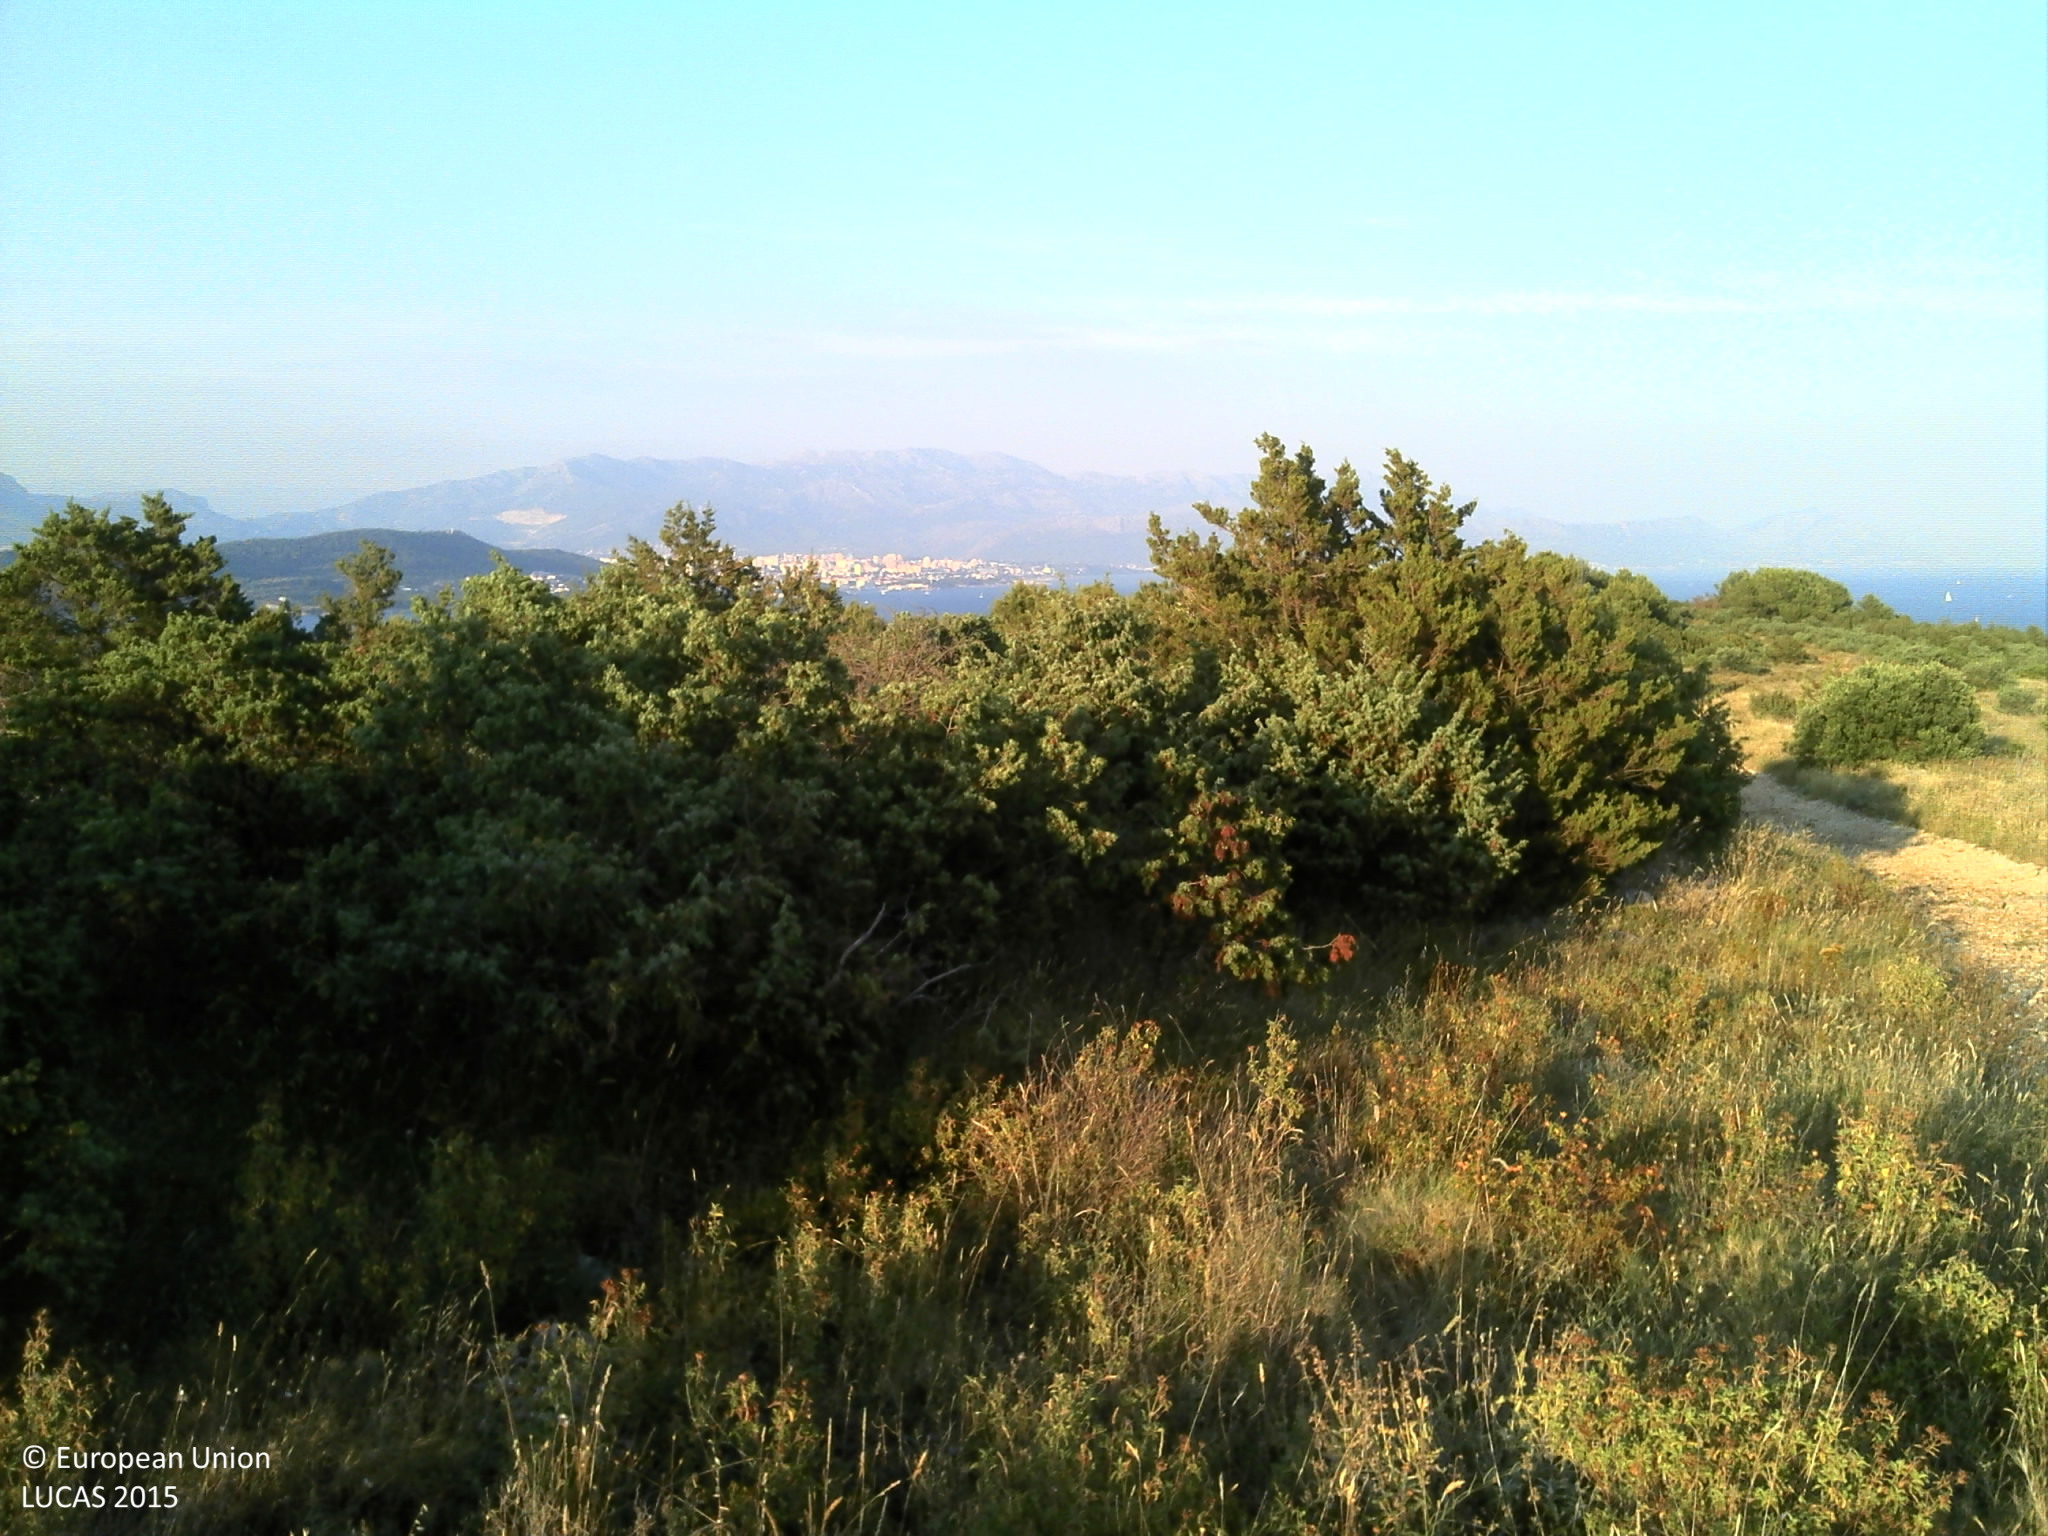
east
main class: Shrubland
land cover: Shrubland without tree cover
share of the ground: 50 - 75 %
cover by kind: shrubs 70 %, herbaceous plants 20 %, consolidated bare surface 5 %, unconsolidated bare surface 5 %
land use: Semi-natural and natural areas not in use
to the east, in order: Tracks; Shrubland without tree cover; Dry stone walls; Shrubland without tree cover; Dry stone walls; Pine dominated coniferous woodland; Dry stone walls; Pine dominated coniferous woodland
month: July
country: HR
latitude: 43.4861
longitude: 16.3584
